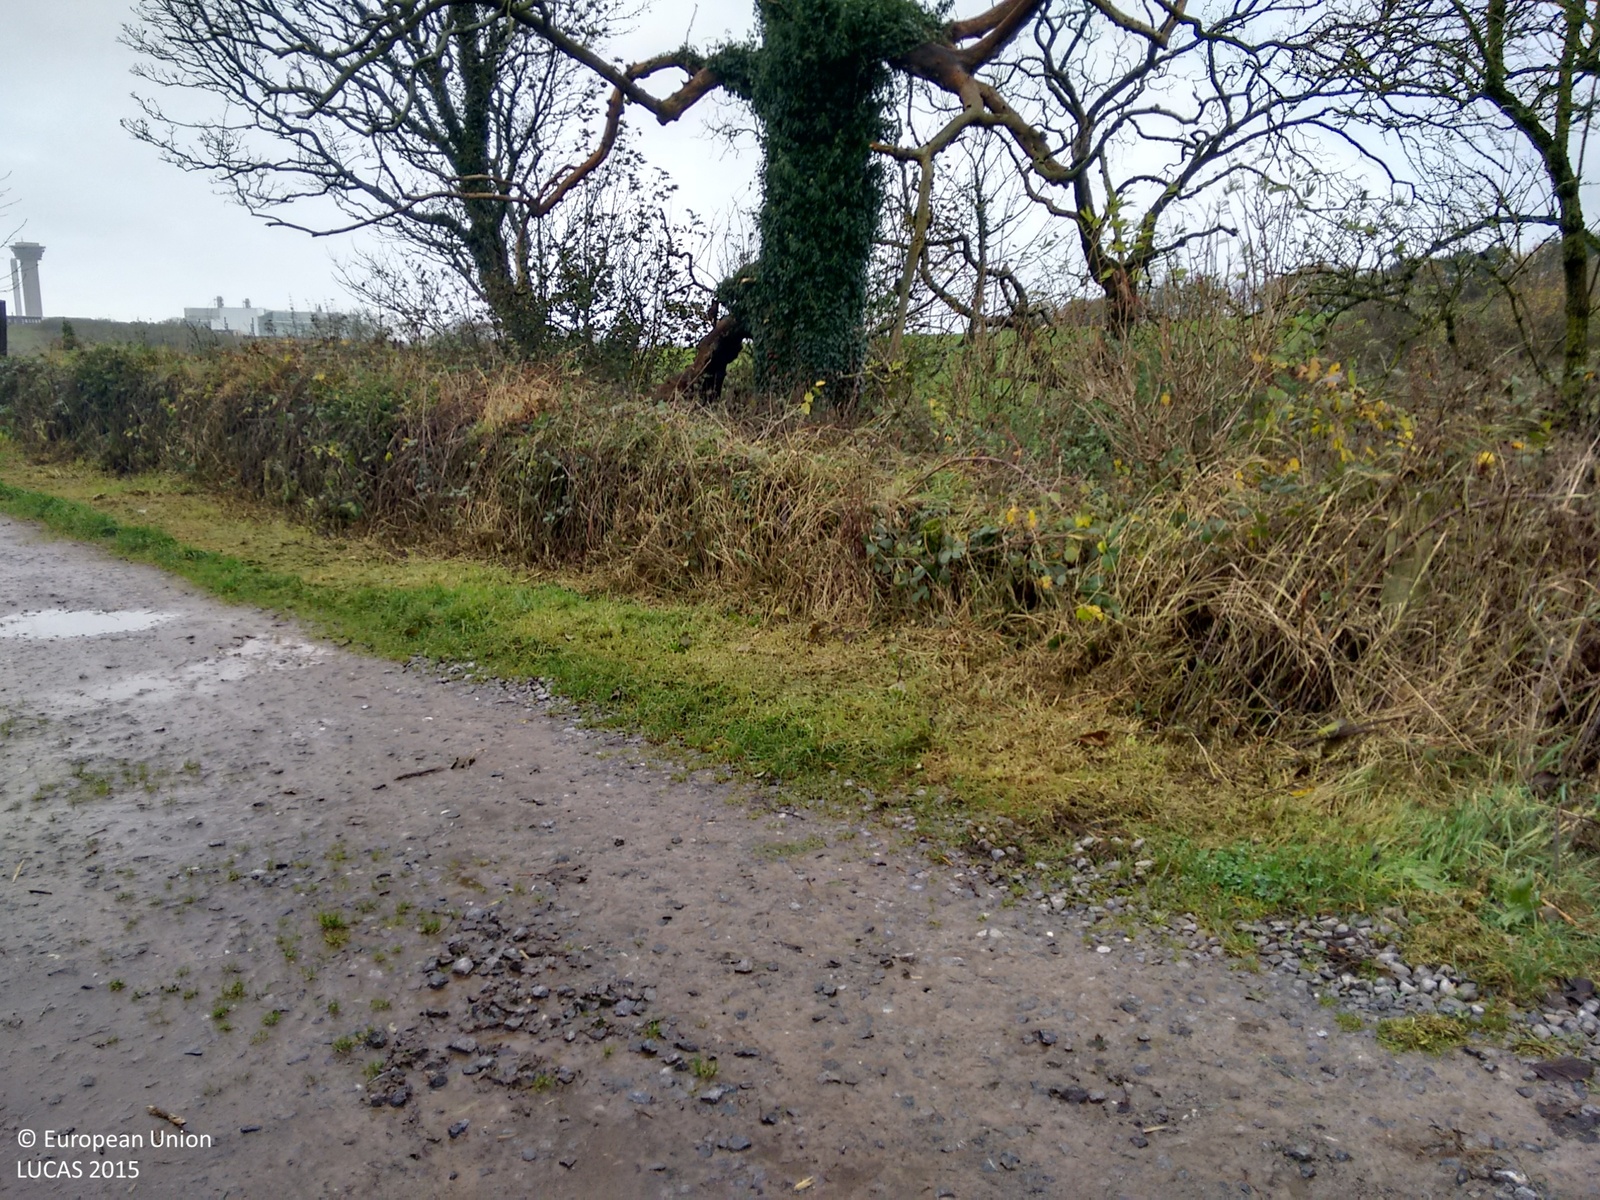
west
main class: Grassland
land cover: Grassland without tree/shrub cover
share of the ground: > 75 %
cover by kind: herbaceous plants 100 %
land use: Agriculture (excluding fallow land and kitchen gardens)
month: November
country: GB
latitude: 54.4319
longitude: -3.4779
